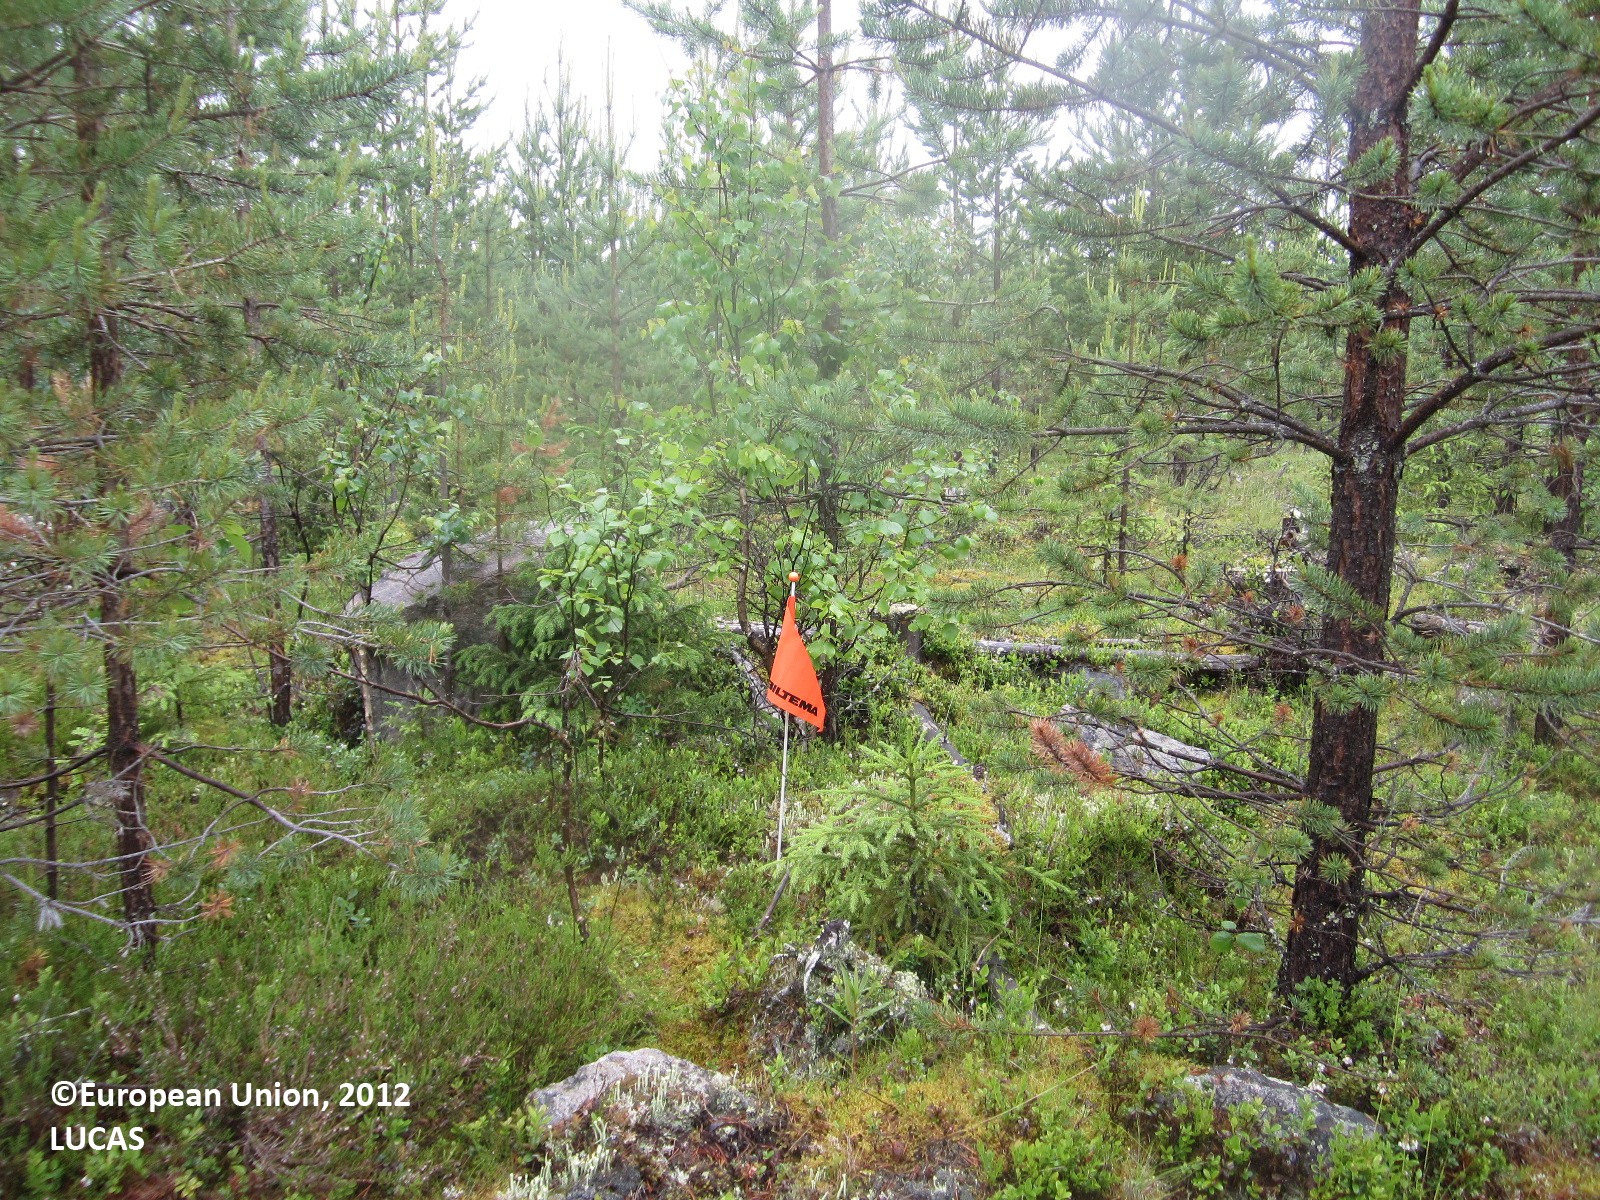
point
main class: Woodland
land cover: Pine dominated coniferous woodland
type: boreal forest
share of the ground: 50 - 75 %
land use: Forestry
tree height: < 5 m
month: June
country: FI
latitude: 64.5432
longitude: 29.8916
